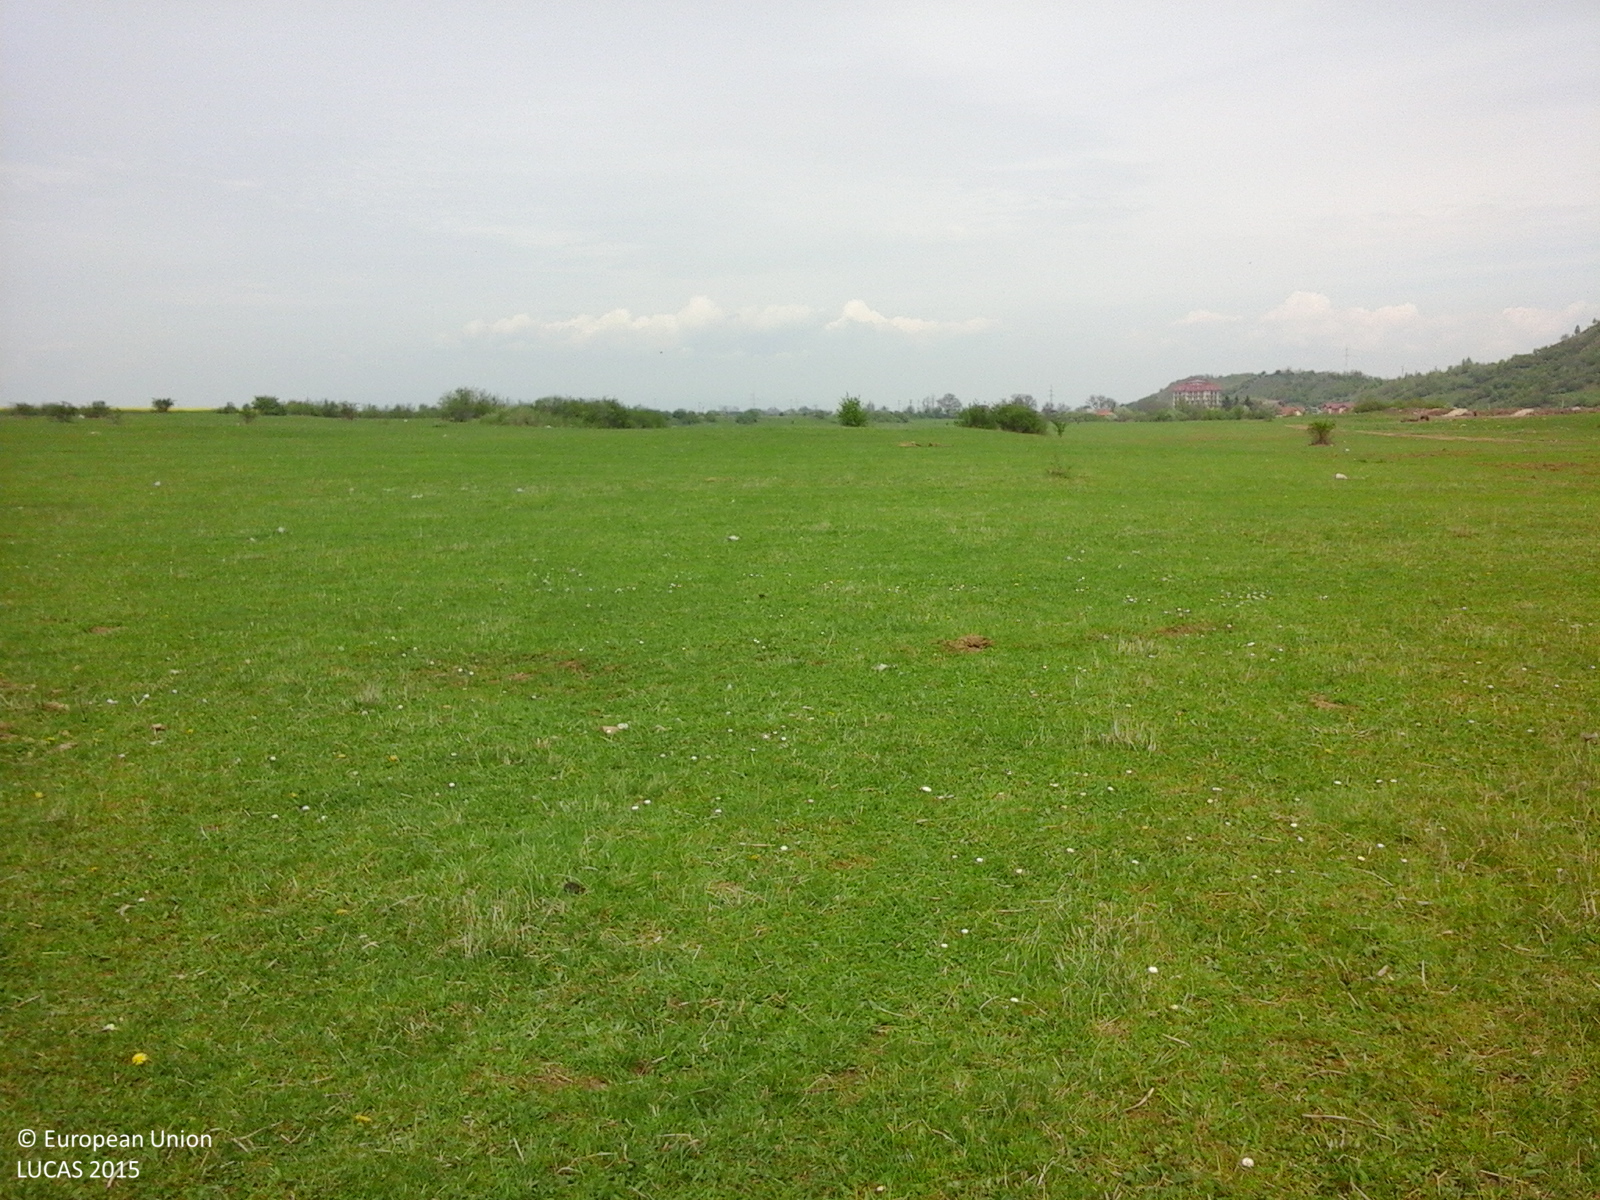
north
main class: Grassland
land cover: Grassland without tree/shrub cover
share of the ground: > 75 %
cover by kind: herbaceous plants 100 %
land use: Agriculture (excluding fallow land and kitchen gardens)
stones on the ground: < 10 %
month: May
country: RO
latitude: 45.6167
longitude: 25.7402
